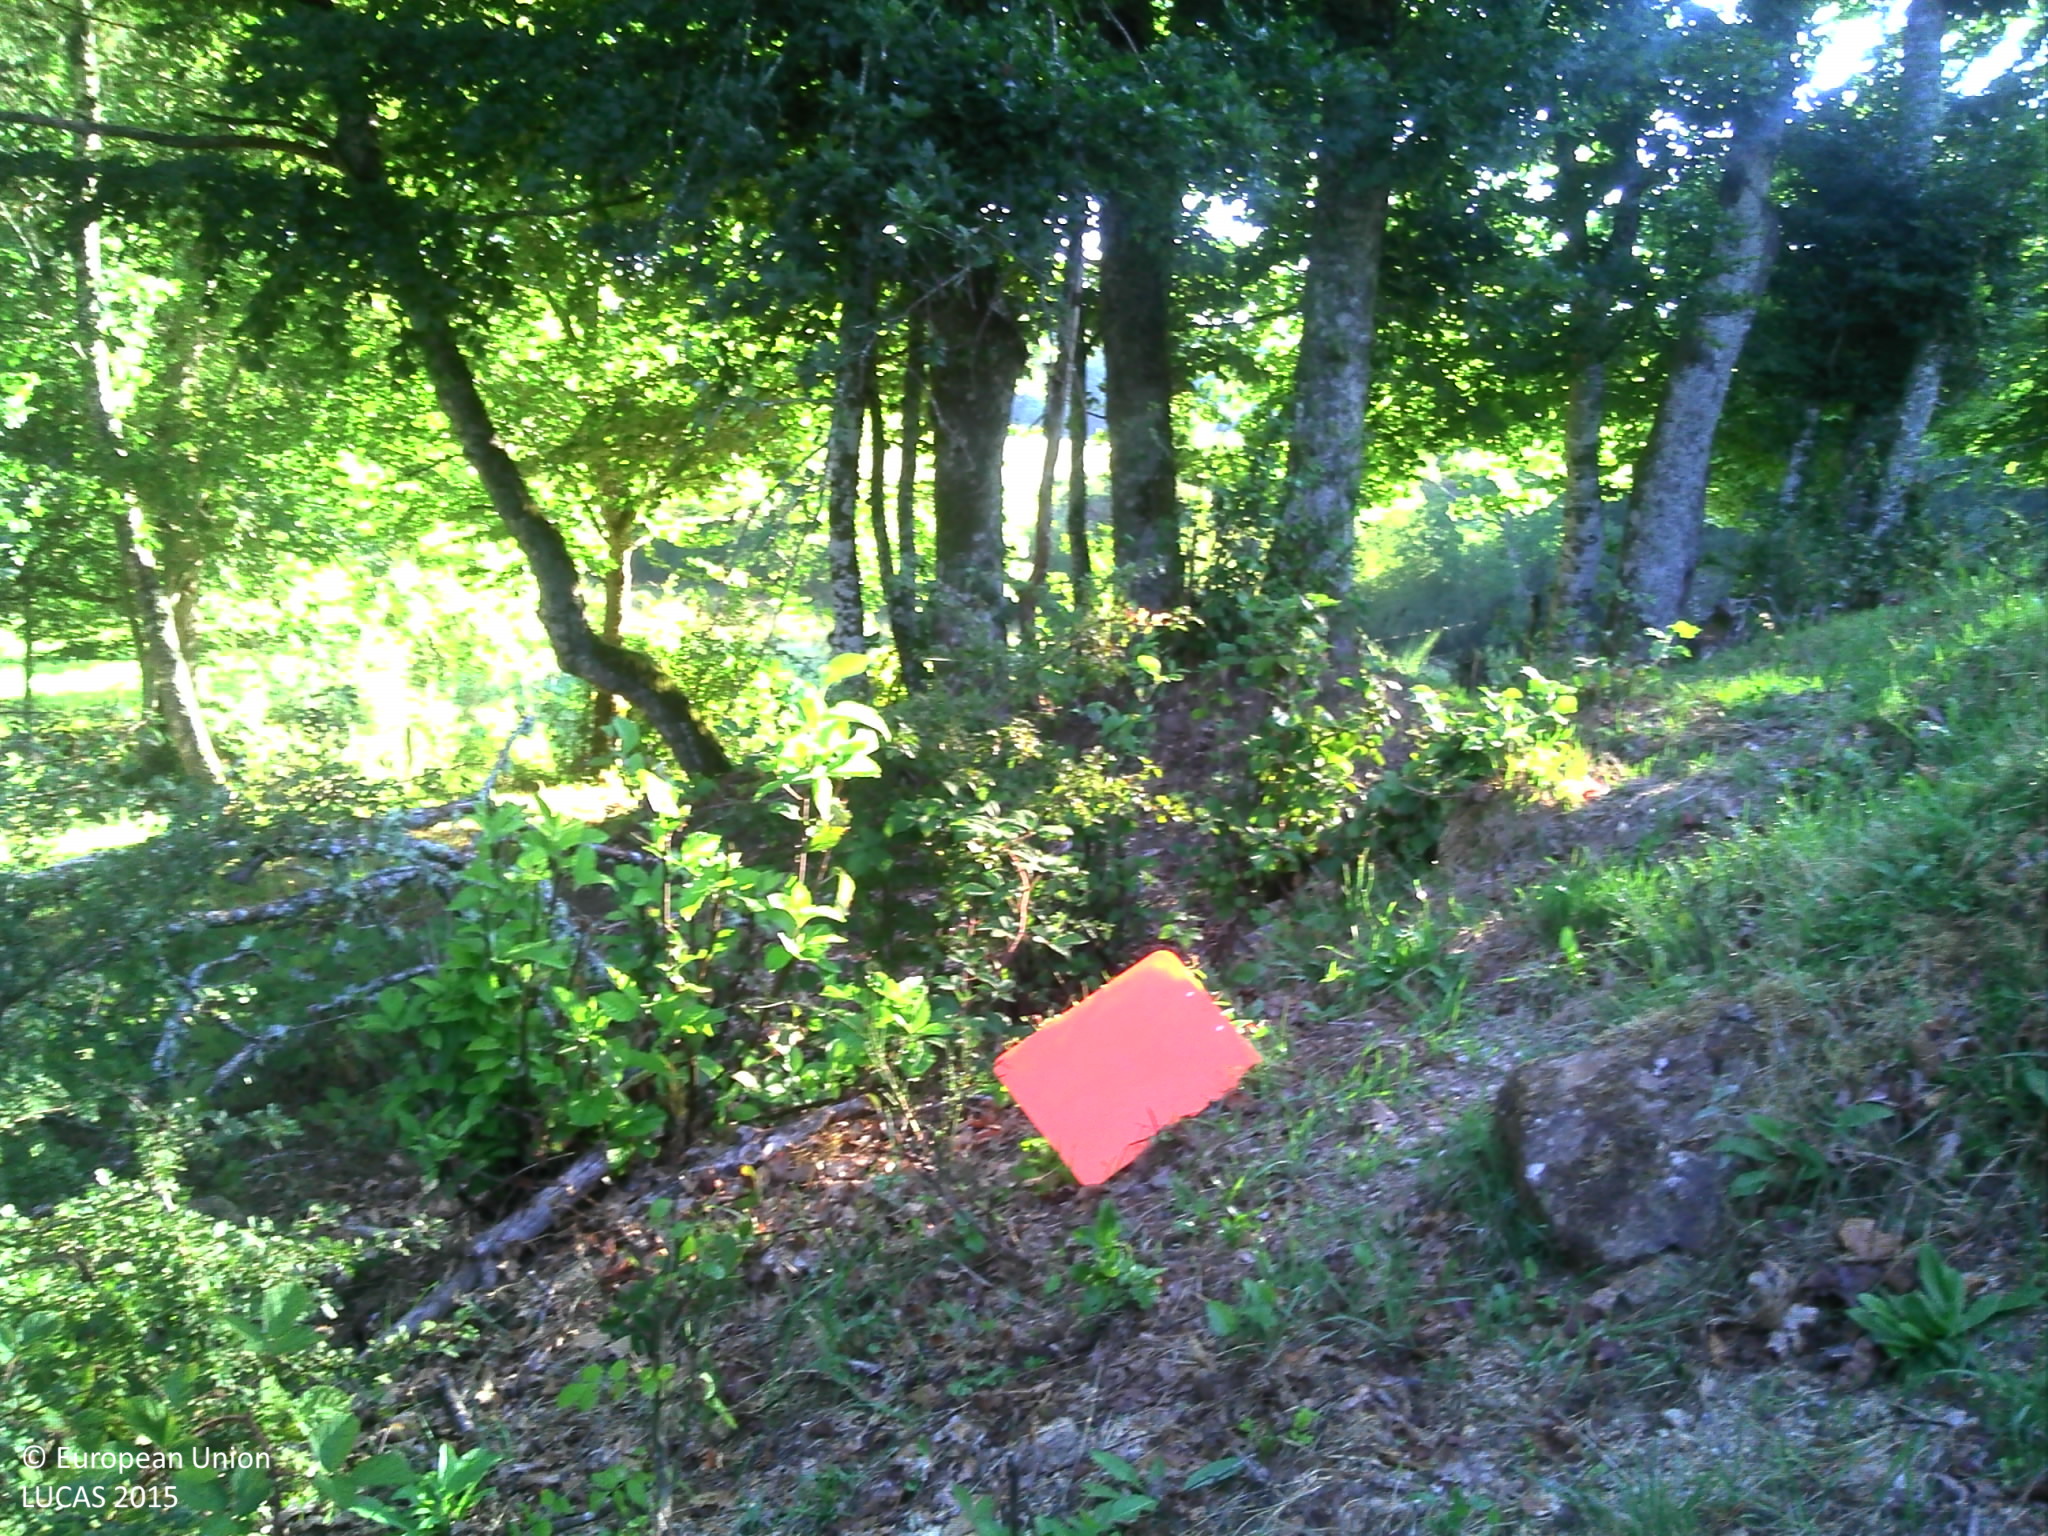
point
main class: Woodland
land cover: Broadleaved woodland
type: acidophilous oak and oak-birch forest
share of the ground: > 75 %
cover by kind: broadleaved forest trees 50 %, herbaceous plants 40 %, shrubs 5 %, lichens and mosses 5 %
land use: Agriculture (excluding fallow land and kitchen gardens)
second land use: Forestry
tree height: > 5 m
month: August
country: FR
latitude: 45.7531
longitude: 2.3738
